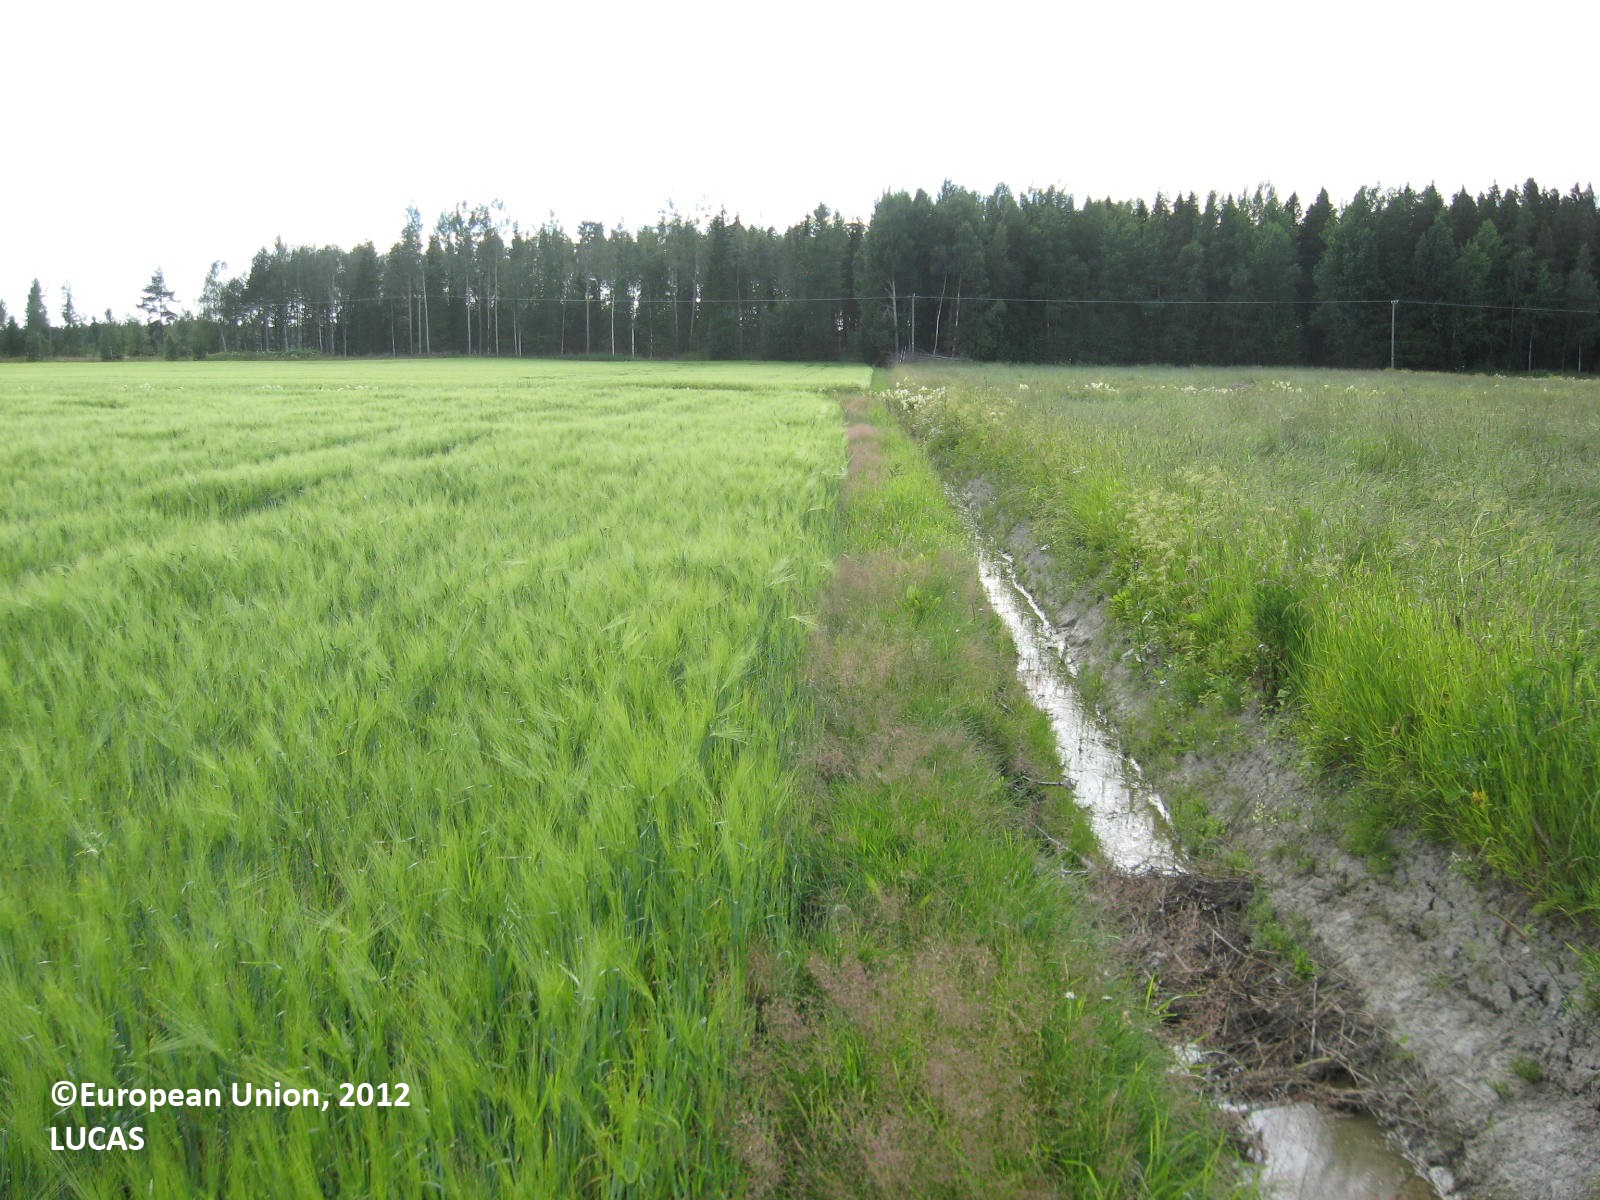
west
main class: Cropland
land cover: Barley
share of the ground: > 75 %
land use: Agriculture (excluding fallow land and kitchen gardens)
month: July
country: FI
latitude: 62.2199
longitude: 21.5664
